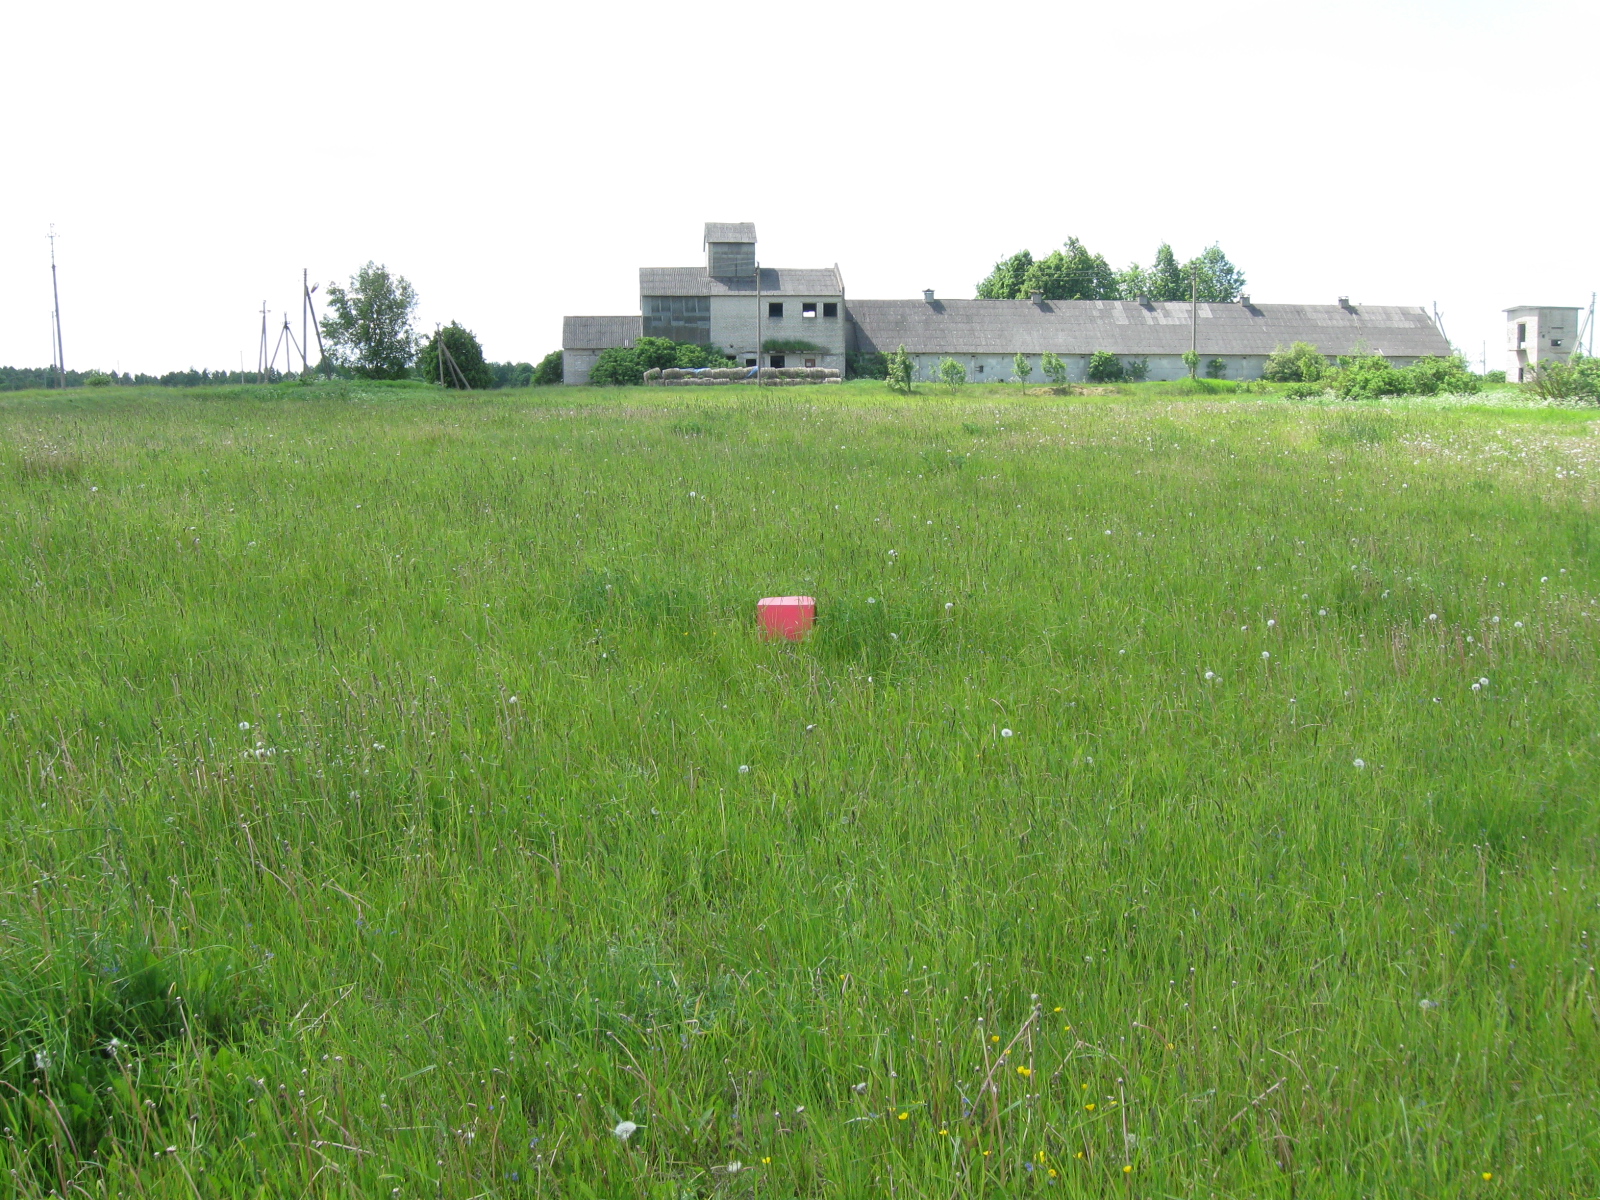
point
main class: Grassland
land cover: Grassland without tree/shrub cover
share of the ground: > 75 %
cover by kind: herbaceous plants 95 %, consolidated bare surface 5 %
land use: Agriculture (excluding fallow land and kitchen gardens)
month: May
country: LT
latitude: 54.3141
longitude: 23.2197
